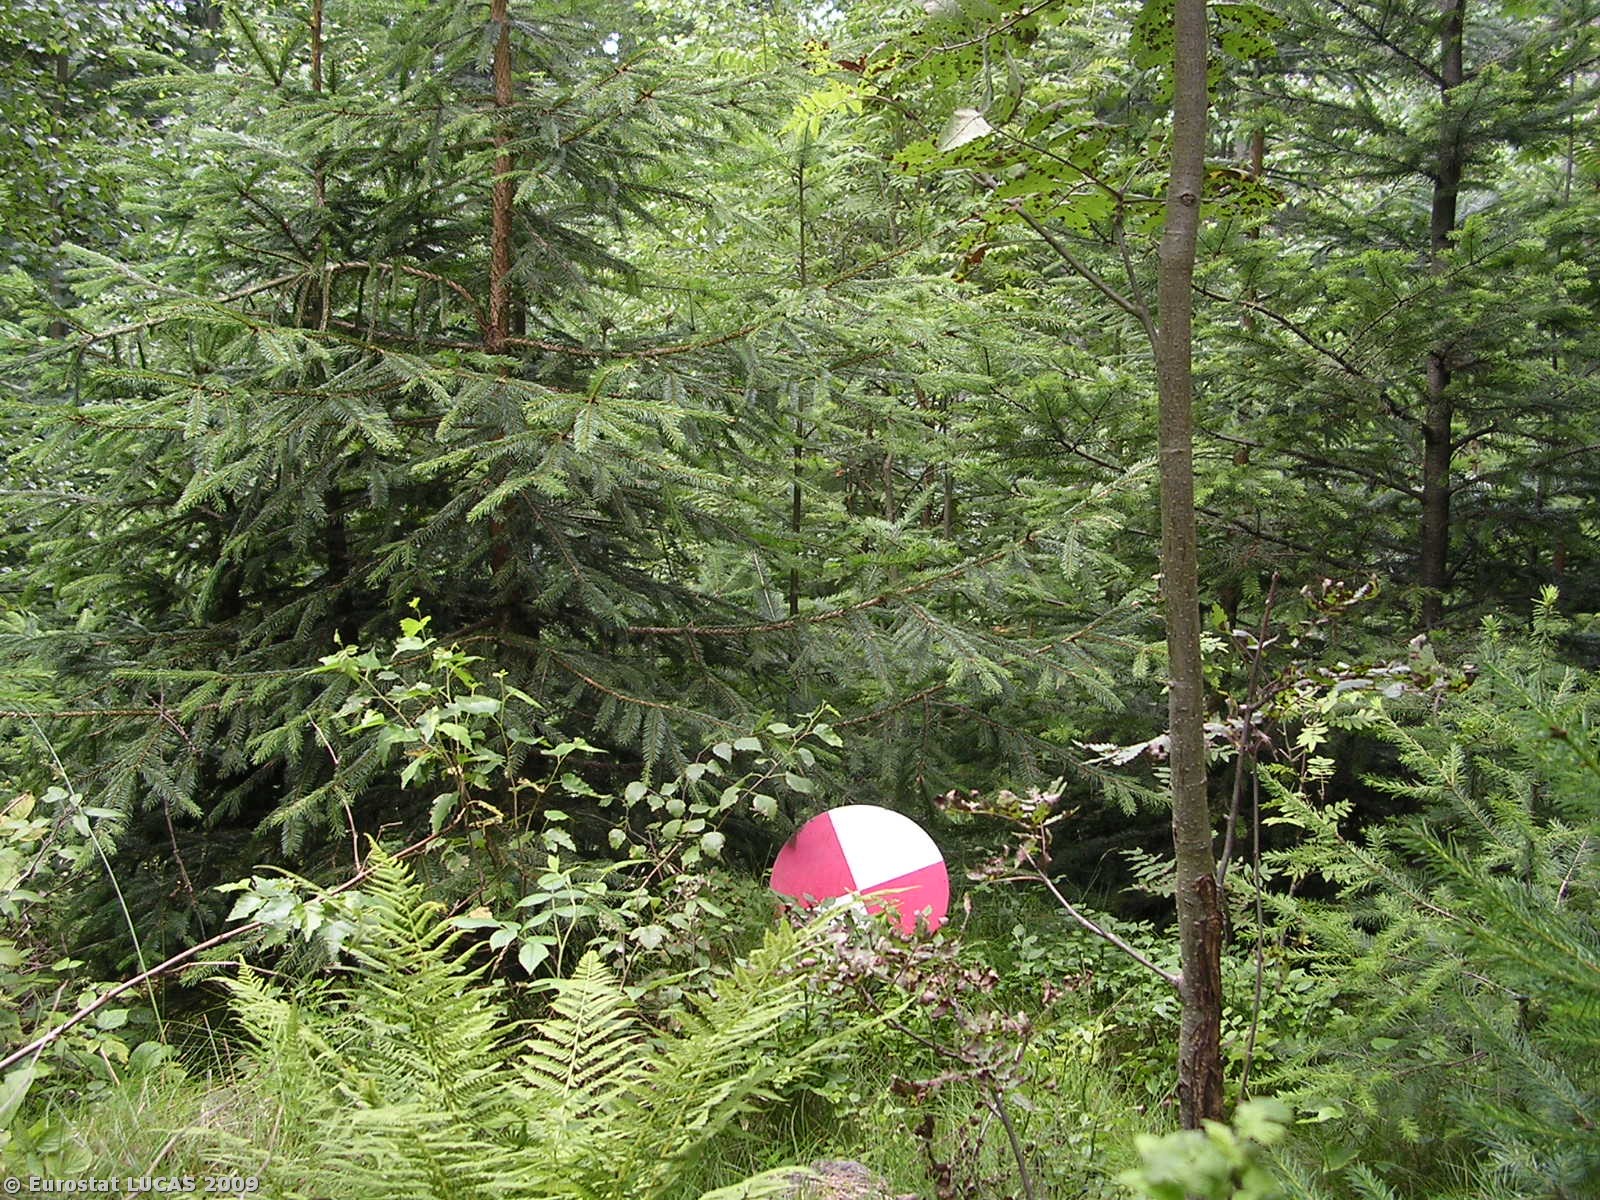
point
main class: Woodland
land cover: Mixed woodland
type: hemiboreal forest and nemoral coniferous forest and mixed broadleaved-coniferous forest
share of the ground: > 75 %
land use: Forestry
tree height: > 5 m
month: July
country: CZ
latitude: 50.7910
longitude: 15.0959
